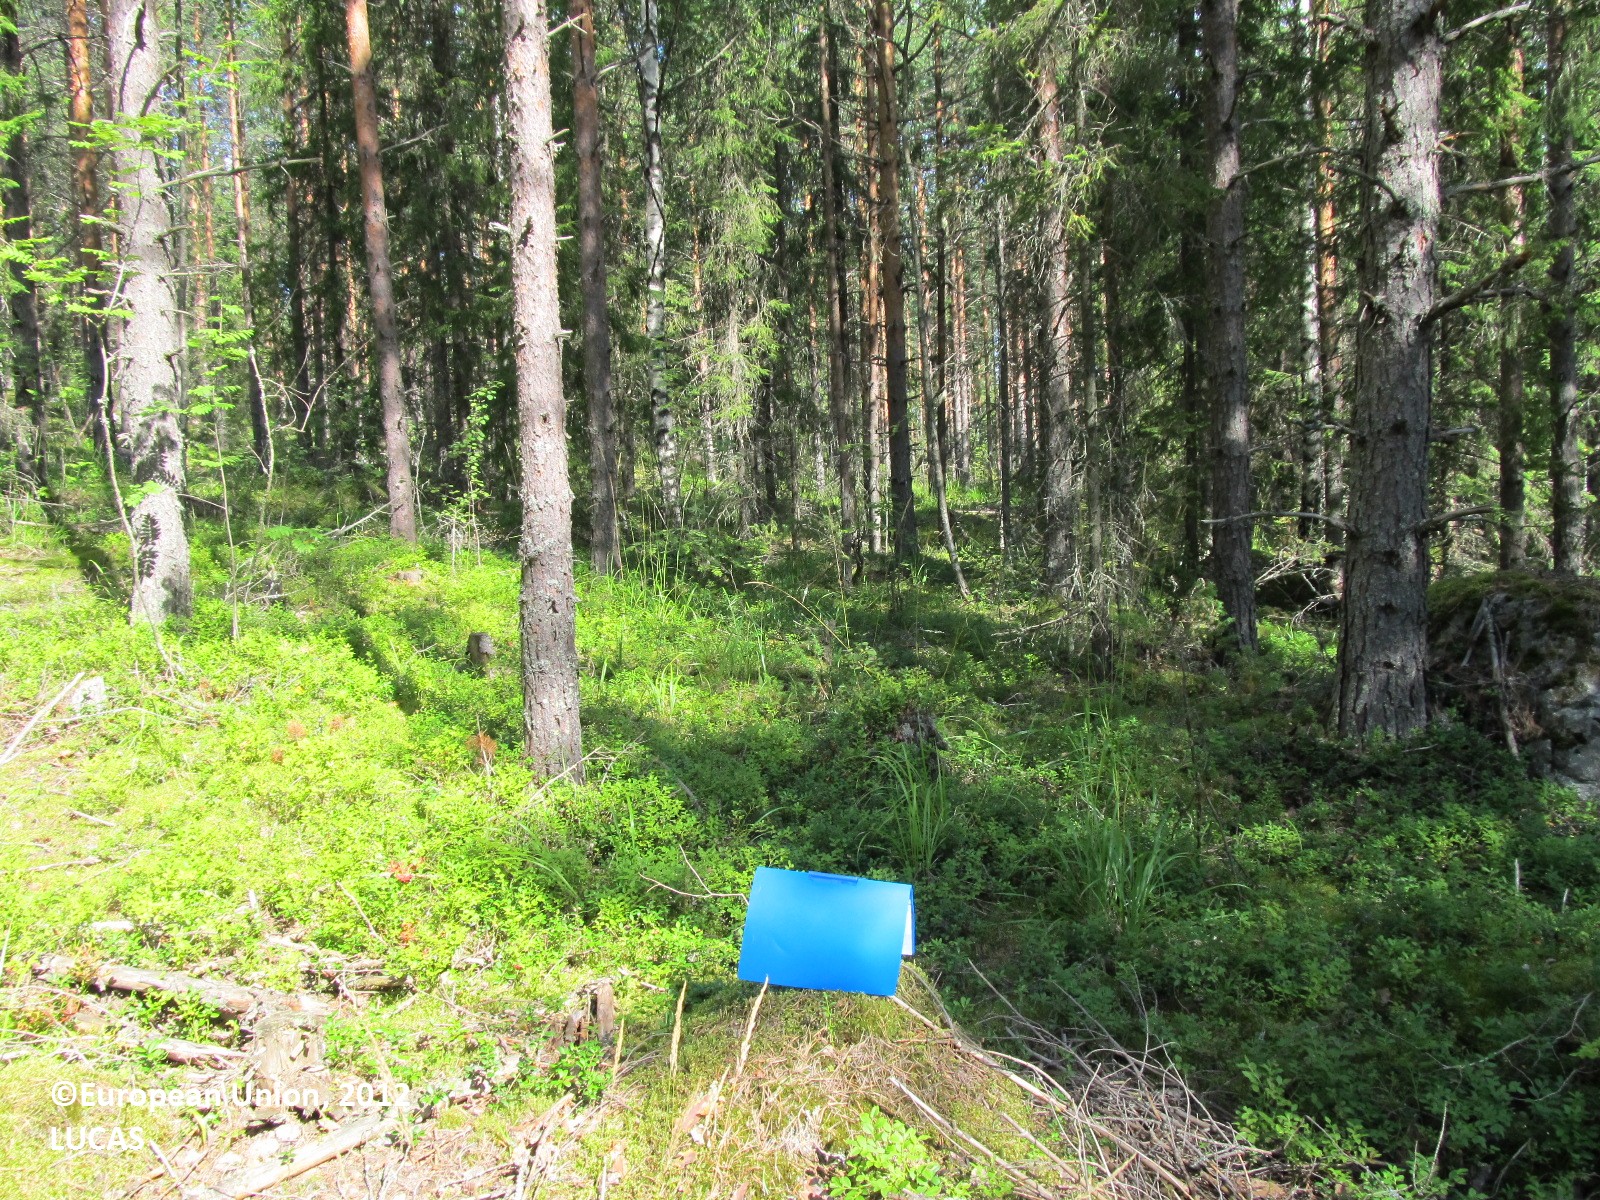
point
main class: Woodland
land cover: Other coniferous woodland
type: boreal forest
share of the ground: 25 - 50 %
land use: Forestry
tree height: > 5 m
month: August
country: FI
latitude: 61.6762
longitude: 27.4233
